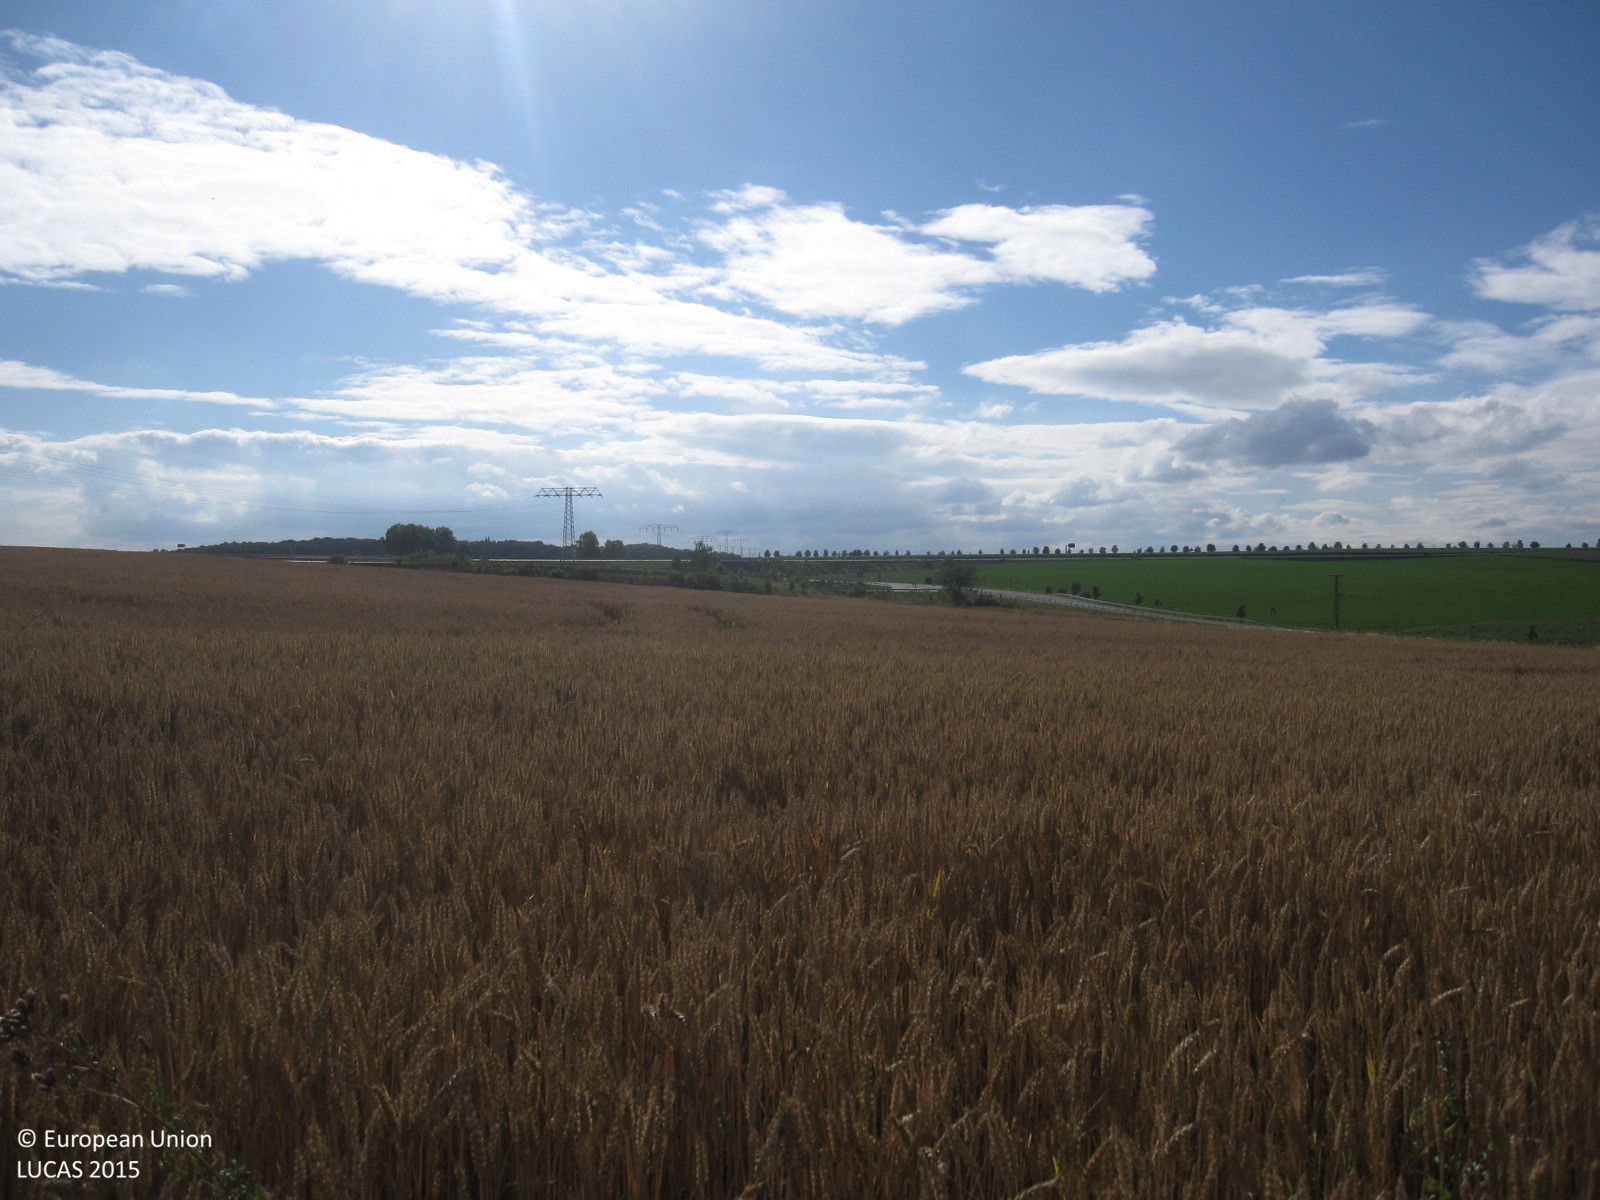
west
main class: Cropland
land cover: Common wheat
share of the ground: > 75 %
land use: Agriculture (excluding fallow land and kitchen gardens)
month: July
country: DE
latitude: 50.9380
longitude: 12.1201
